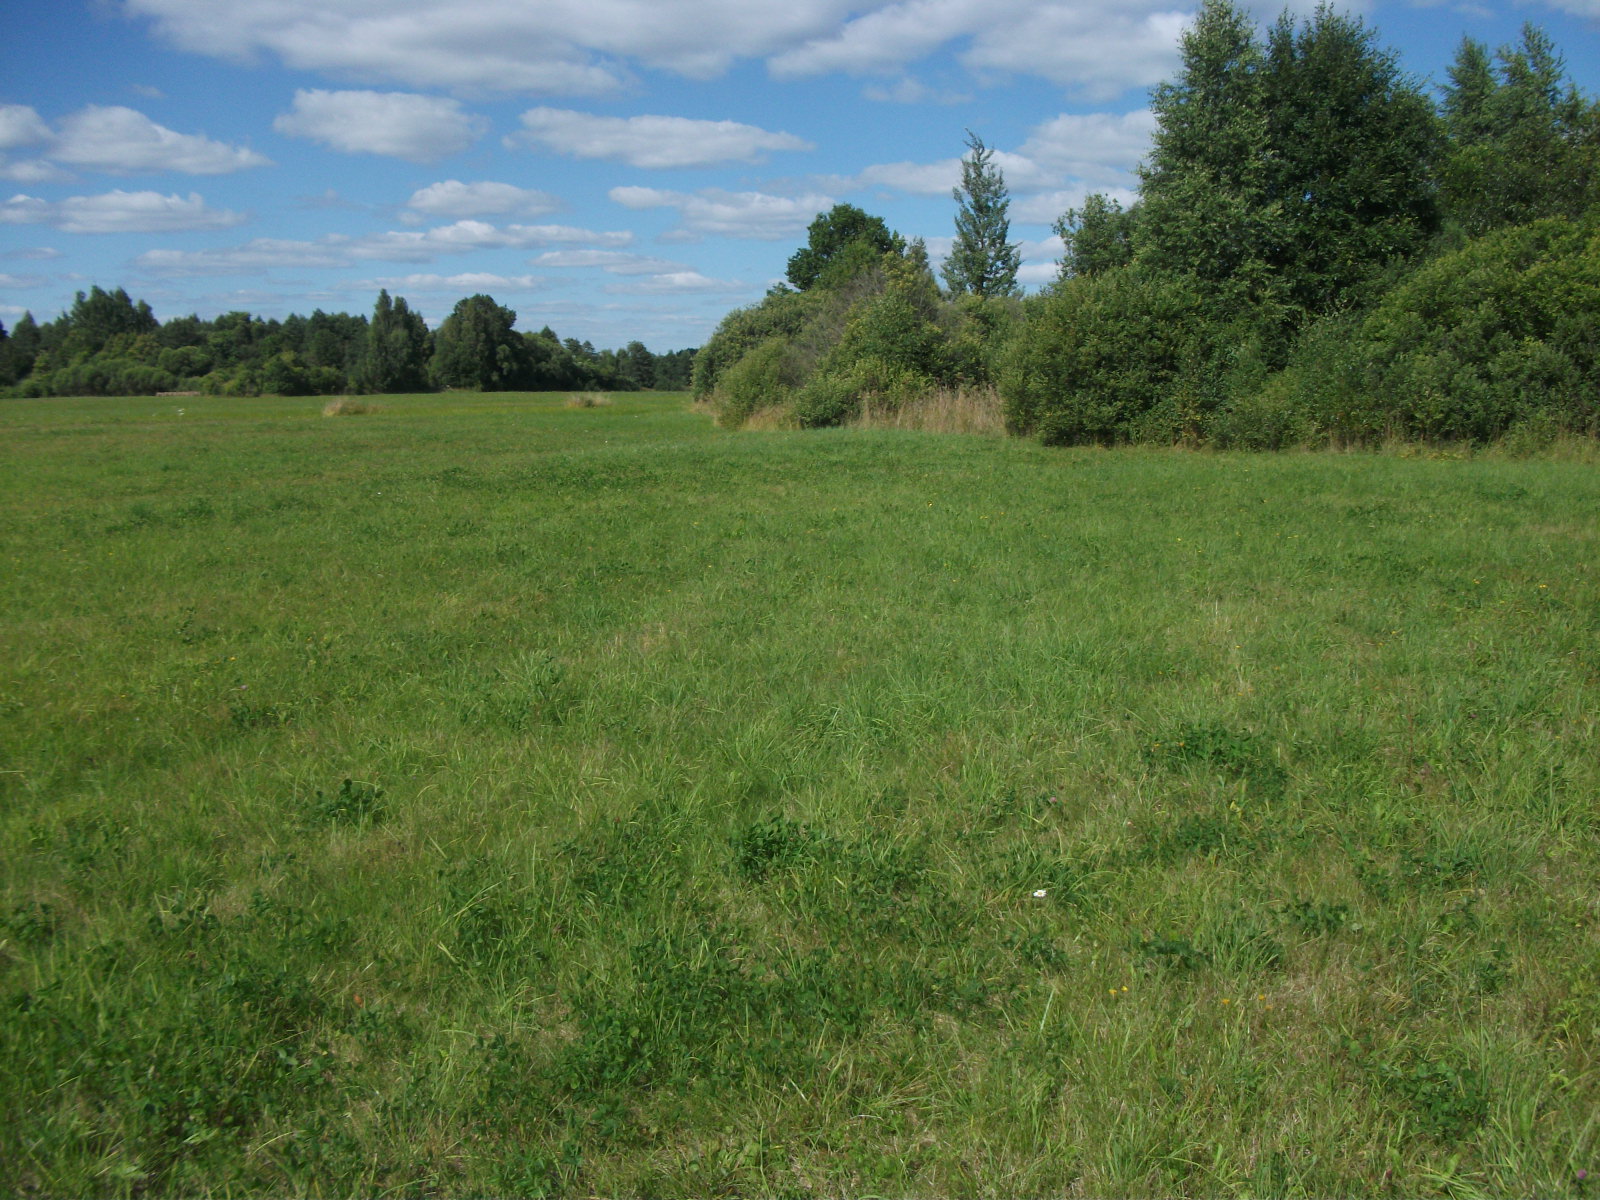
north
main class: Grassland
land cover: Grassland without tree/shrub cover
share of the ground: > 75 %
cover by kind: herbaceous plants 100 %
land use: Agriculture (excluding fallow land and kitchen gardens)
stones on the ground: < 10 %
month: August
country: LV
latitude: 56.4310
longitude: 26.3766
